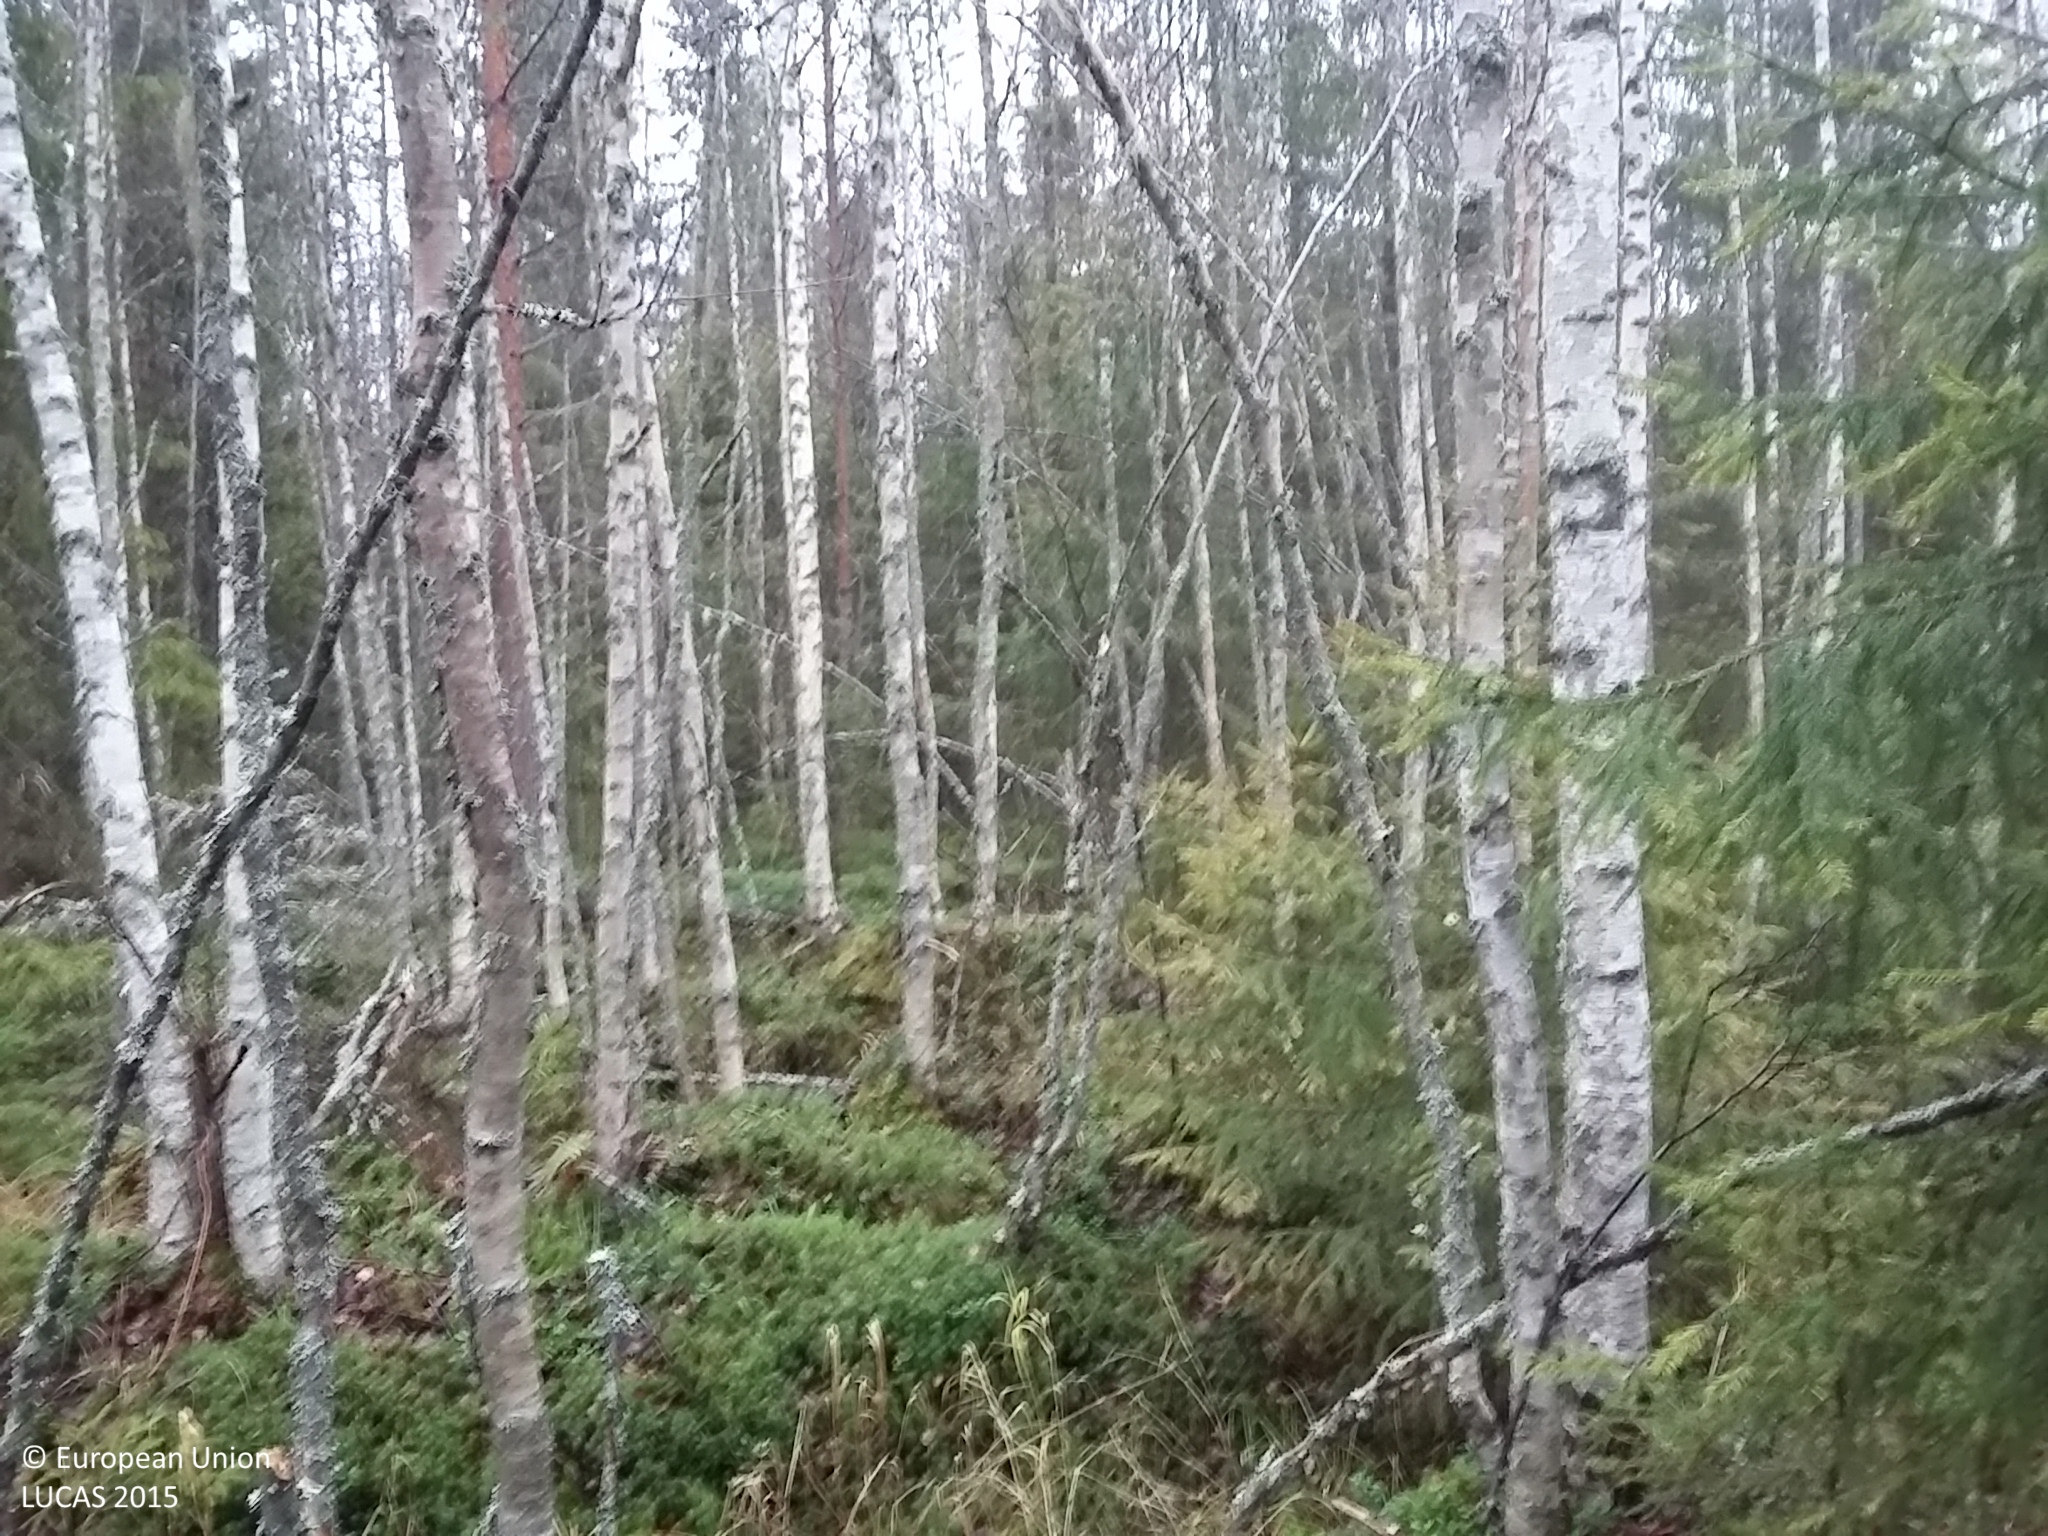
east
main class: Woodland
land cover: Other mixed woodland
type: boreal forest
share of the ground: > 75 %
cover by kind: coniferous forest trees 45 %, broadleaved forest trees 45 %, herbaceous plants 5 %, lichens and mosses 5 %
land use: Forestry
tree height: > 5 m
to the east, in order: Other mixed woodland; Ditches and canals; Spruce dominated mixed woodland; Ditches and canals; Spruce dominated mixed woodland; Ditches and canals; Spruce dominated mixed woodland; Ditches and canals; Spruce dominated mixed woodland; Ditches and canals; Spruce dominated mixed woodland; Tracks; Spruce dominated mixed woodland
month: October
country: FI
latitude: 64.3240
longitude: 25.2067
